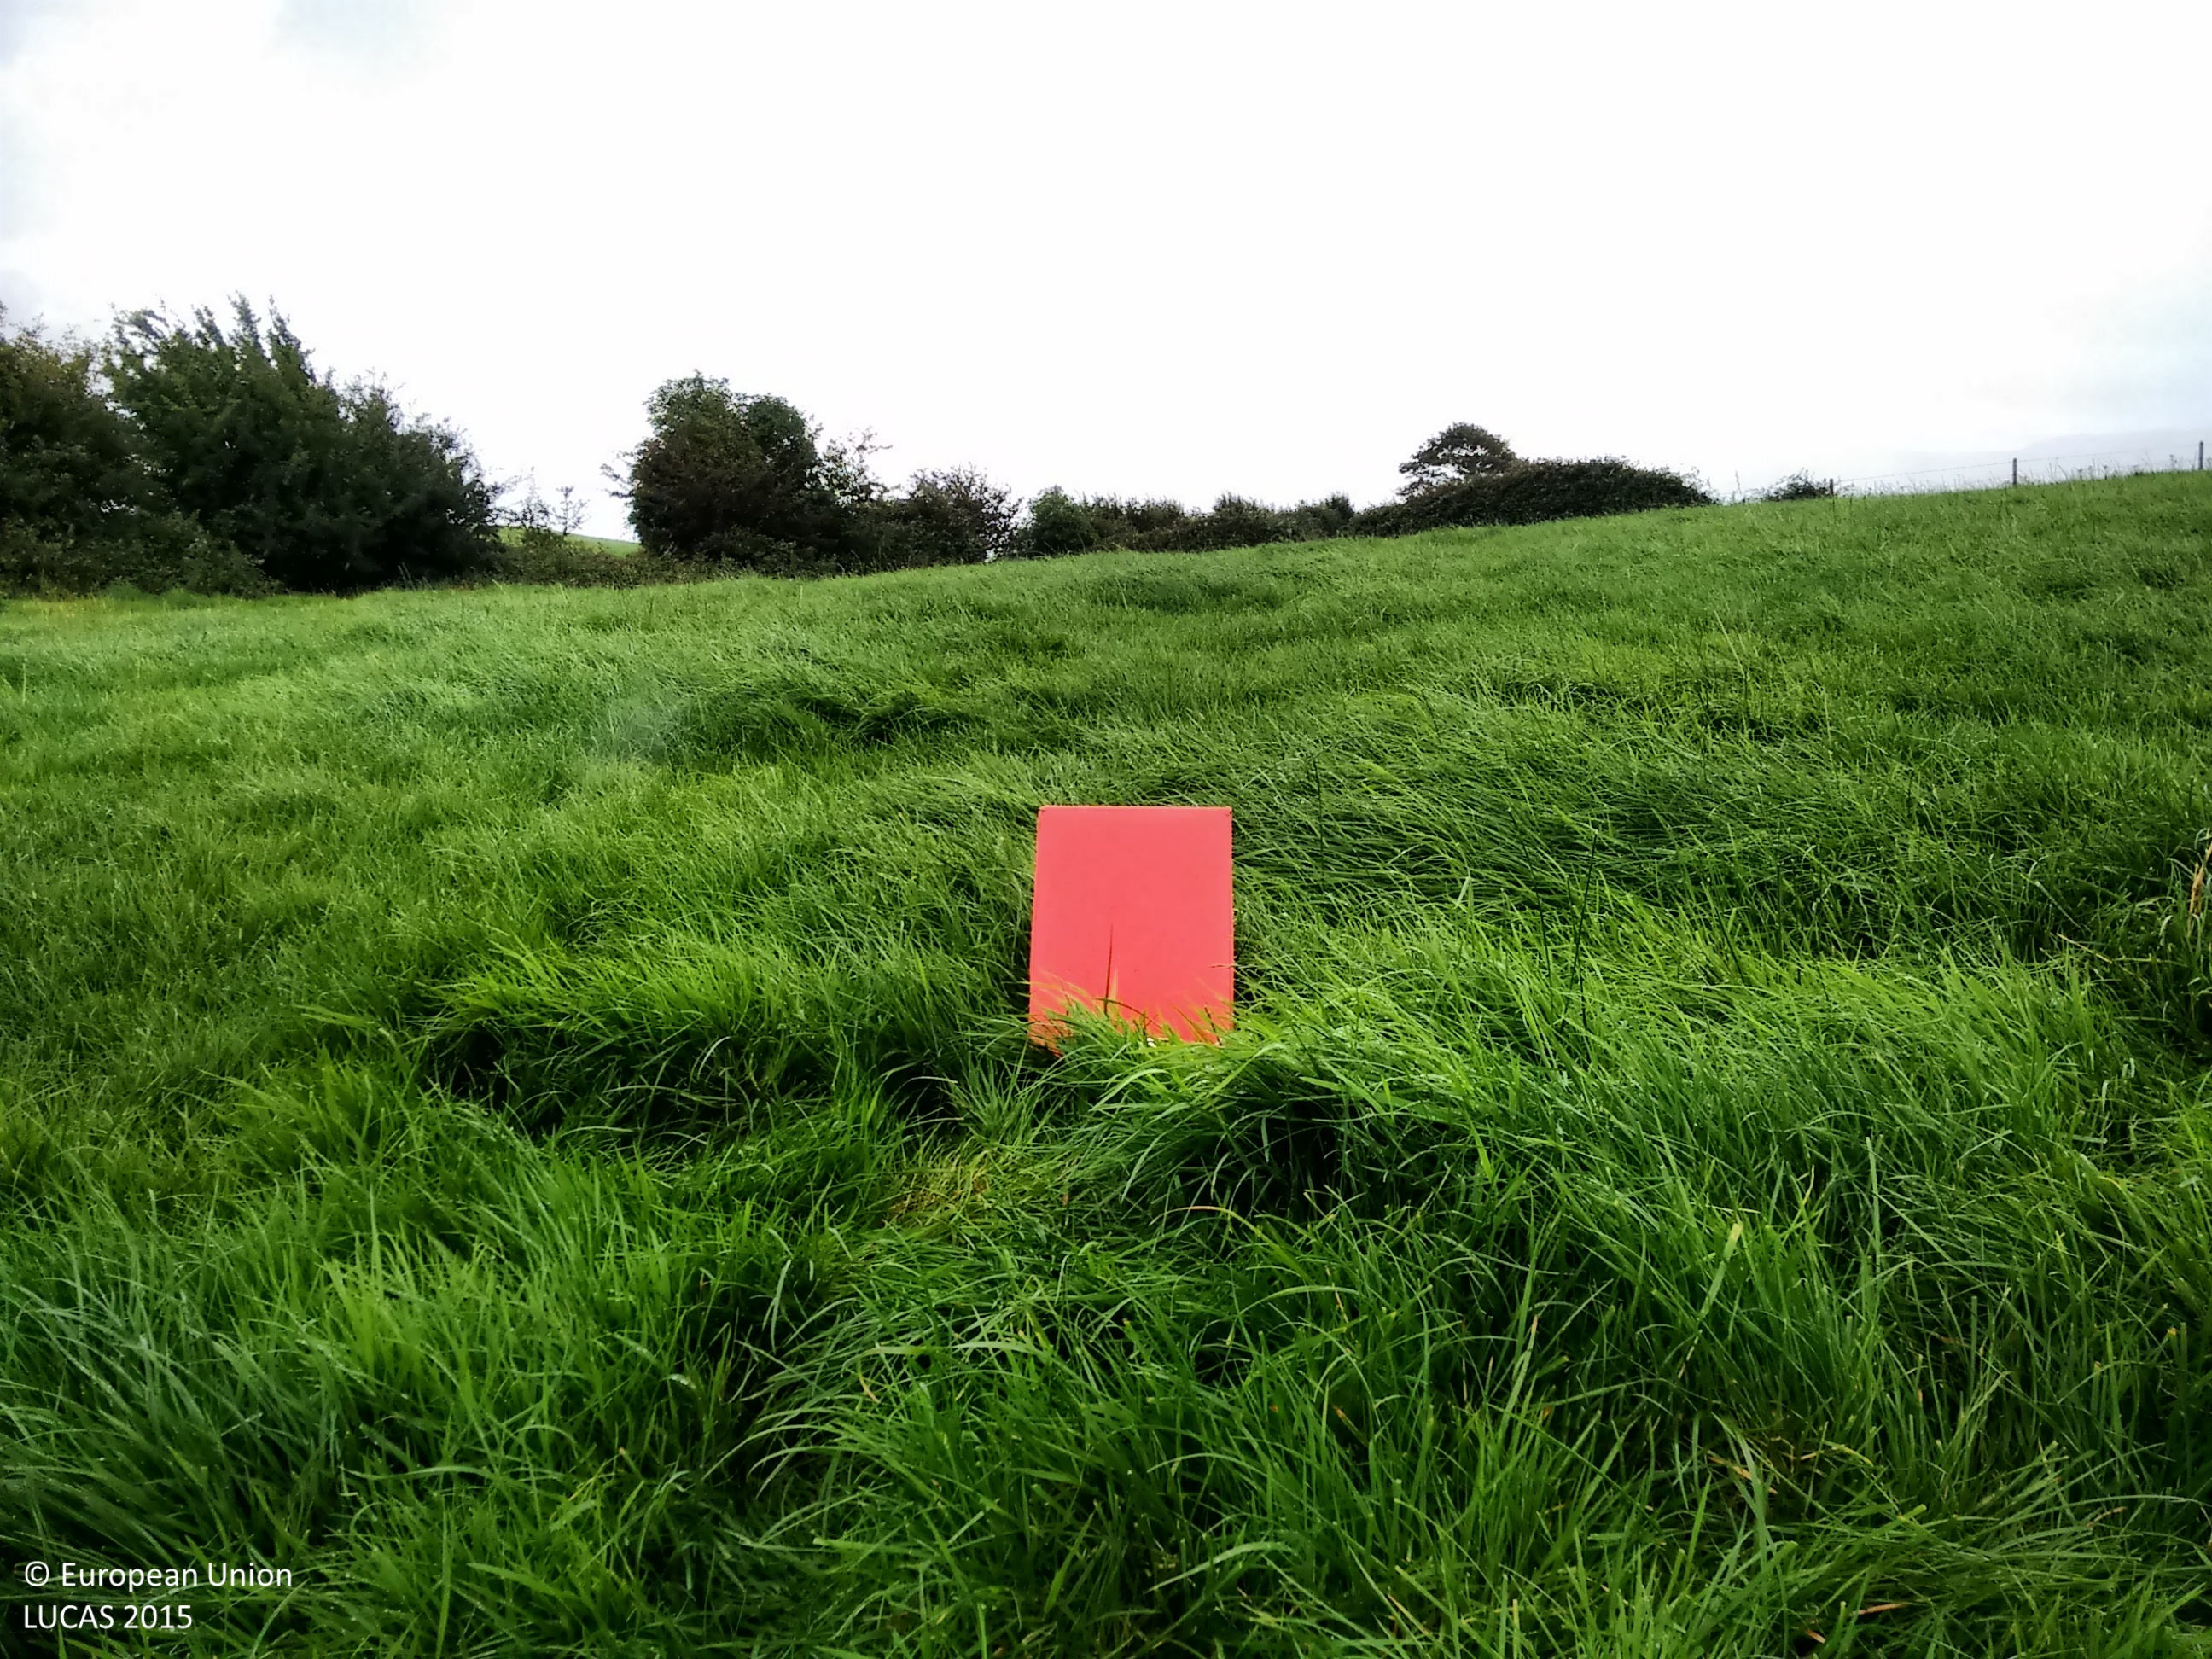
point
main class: Grassland
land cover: Grassland without tree/shrub cover
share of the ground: > 75 %
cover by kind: herbaceous plants 100 %
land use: Agriculture (excluding fallow land and kitchen gardens)
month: August
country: IE
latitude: 52.0851
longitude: -9.6334
